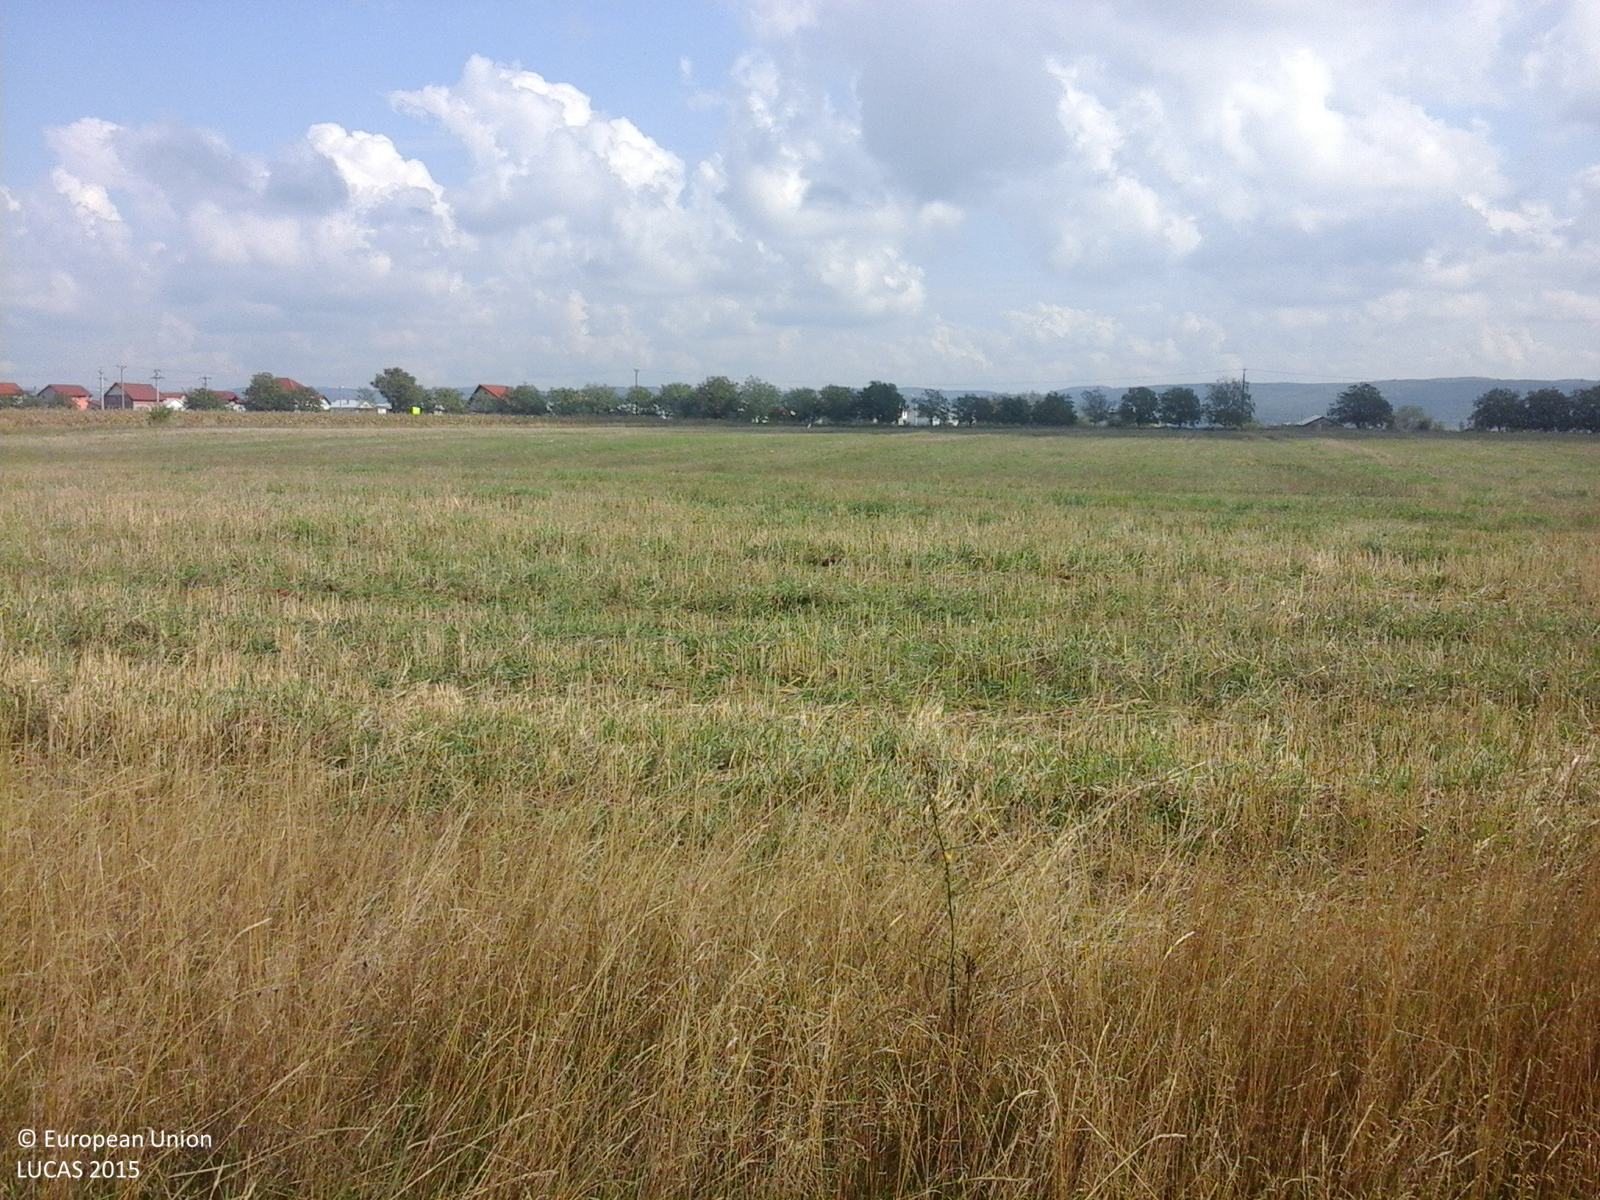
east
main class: Grassland
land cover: Spontaneously vegetated surfaces
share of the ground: > 75 %
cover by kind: herbaceous plants 100 %
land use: Fallow land
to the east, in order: Spontaneously vegetated surfaces; Common wheat; Grass margins; Common wheat; Spontaneously vegetated surfaces; Maize
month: September
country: RO
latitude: 45.0278
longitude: 23.5499
